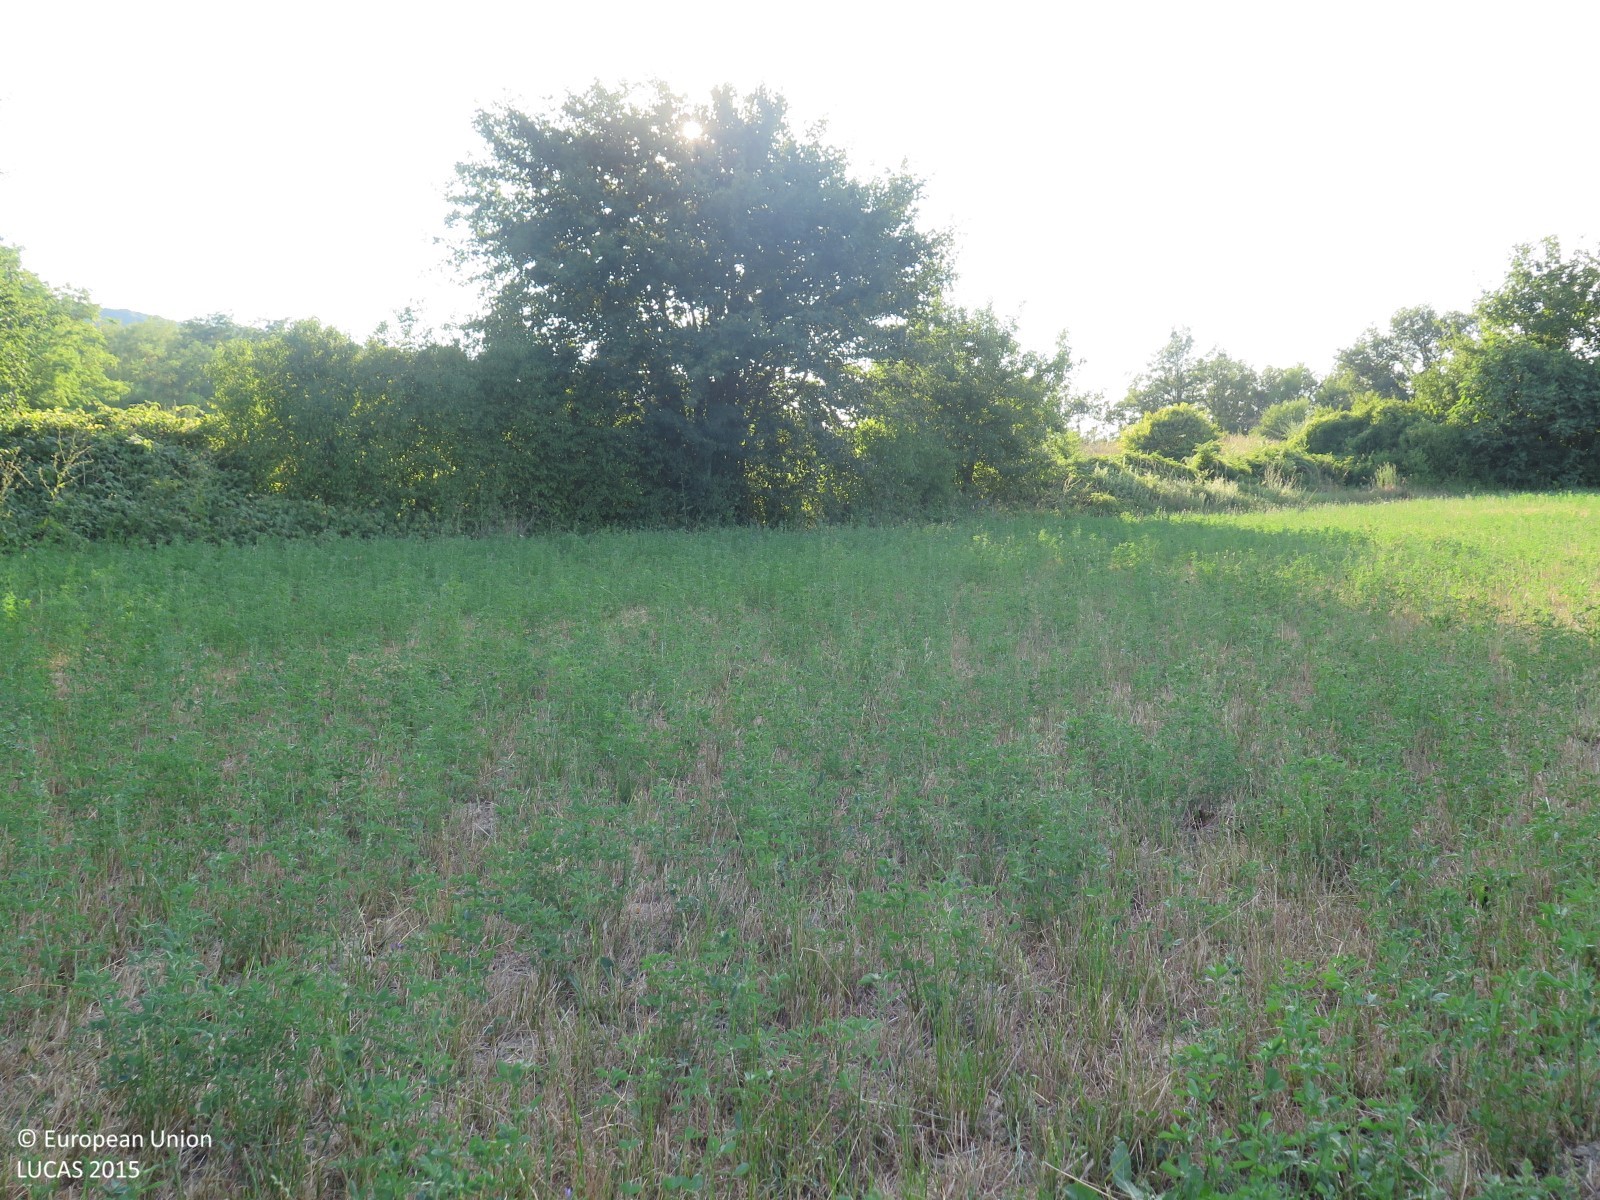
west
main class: Cropland
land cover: Lucerne
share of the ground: > 75 %
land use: Agriculture (excluding fallow land and kitchen gardens)
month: July
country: HR
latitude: 45.2100
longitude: 14.0564
